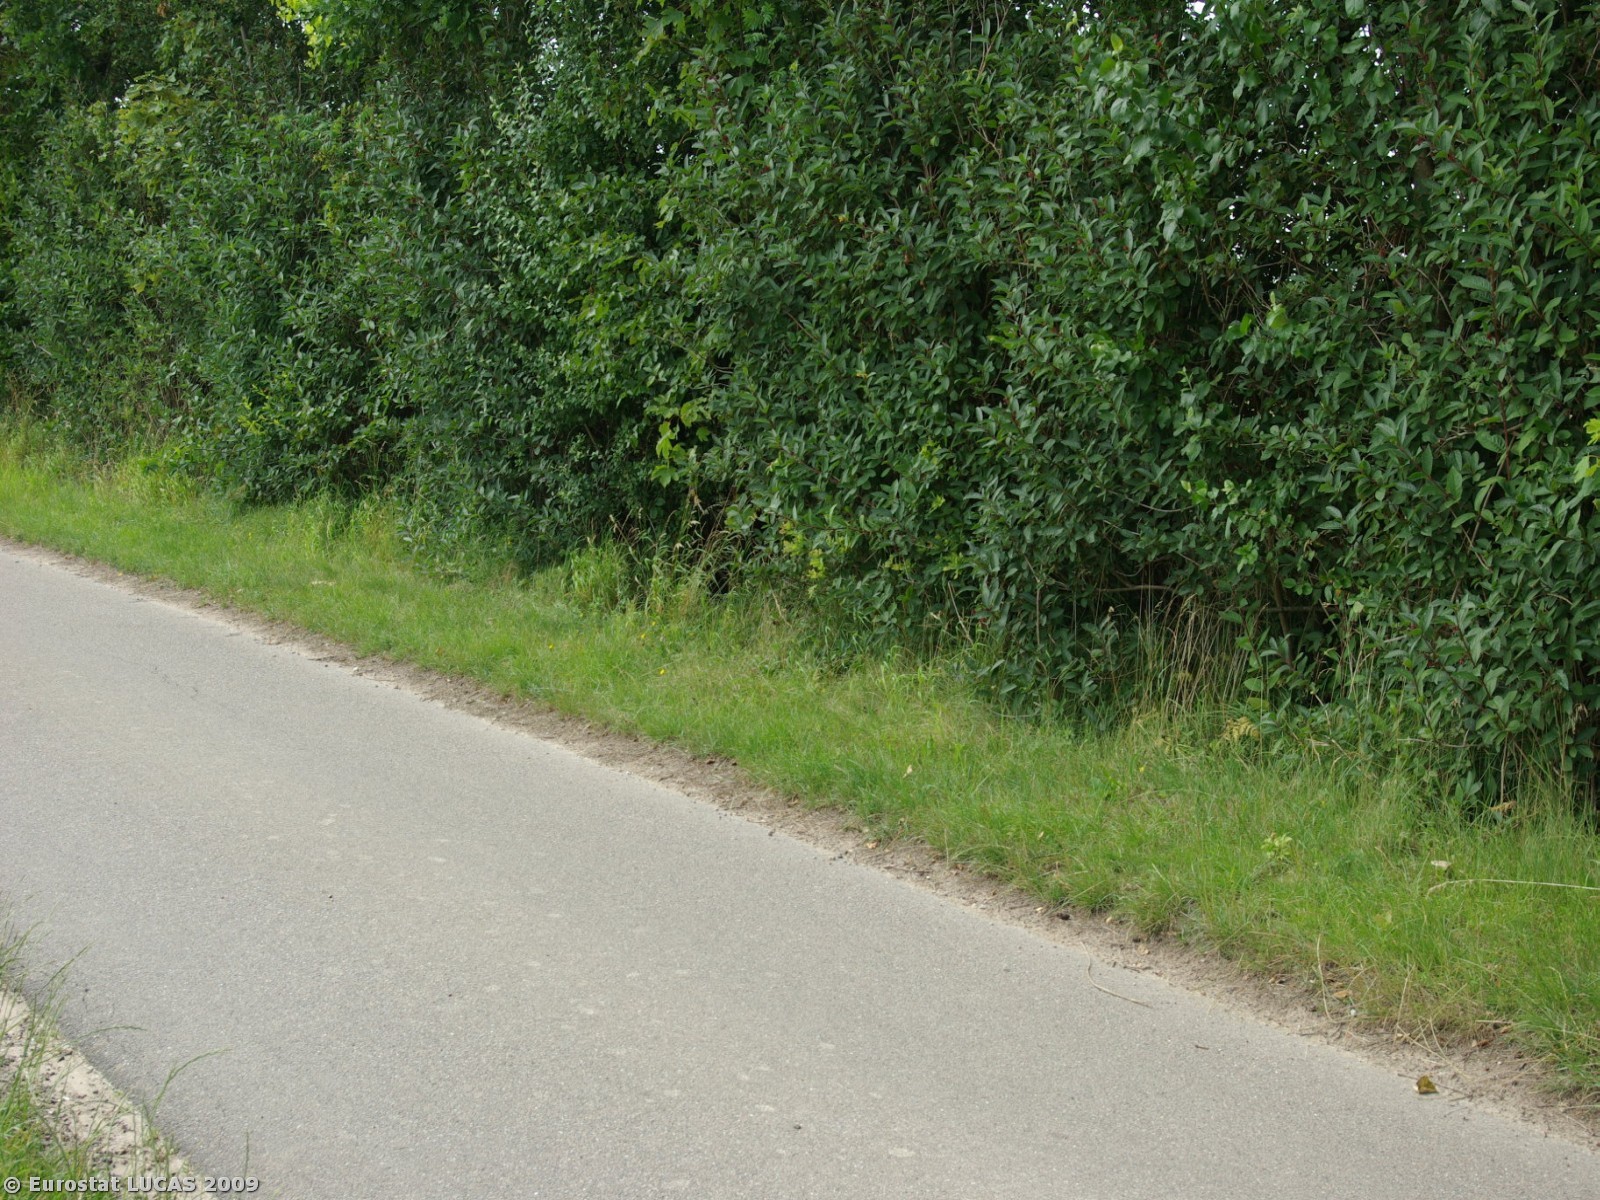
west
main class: Cropland
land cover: Barley
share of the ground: > 75 %
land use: Agriculture (excluding fallow land and kitchen gardens)
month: July
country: DK
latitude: 54.8936
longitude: 10.0467
